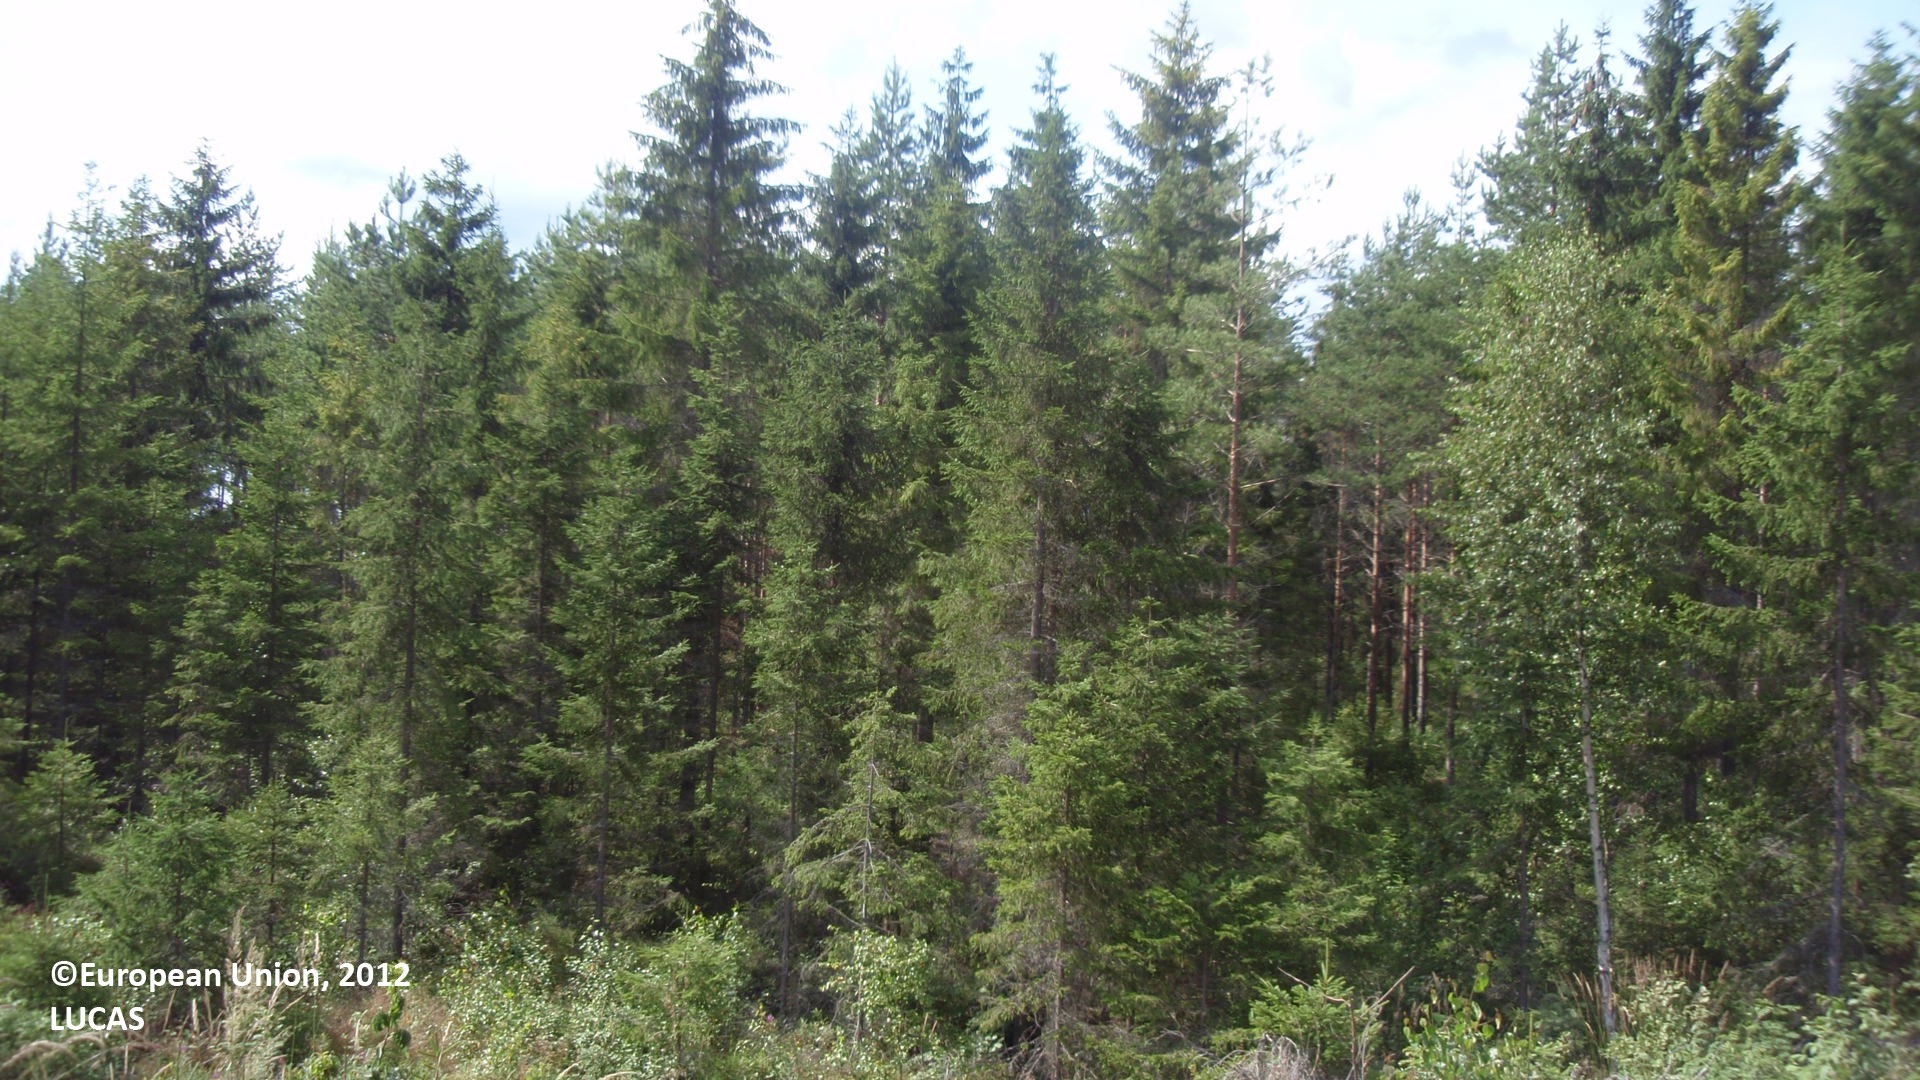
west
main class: Woodland
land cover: Spruce dominated mixed woodland
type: boreal forest
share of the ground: 10 - 25 %
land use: Forestry
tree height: < 5 m
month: July
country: FI
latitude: 61.4723
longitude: 28.7474
